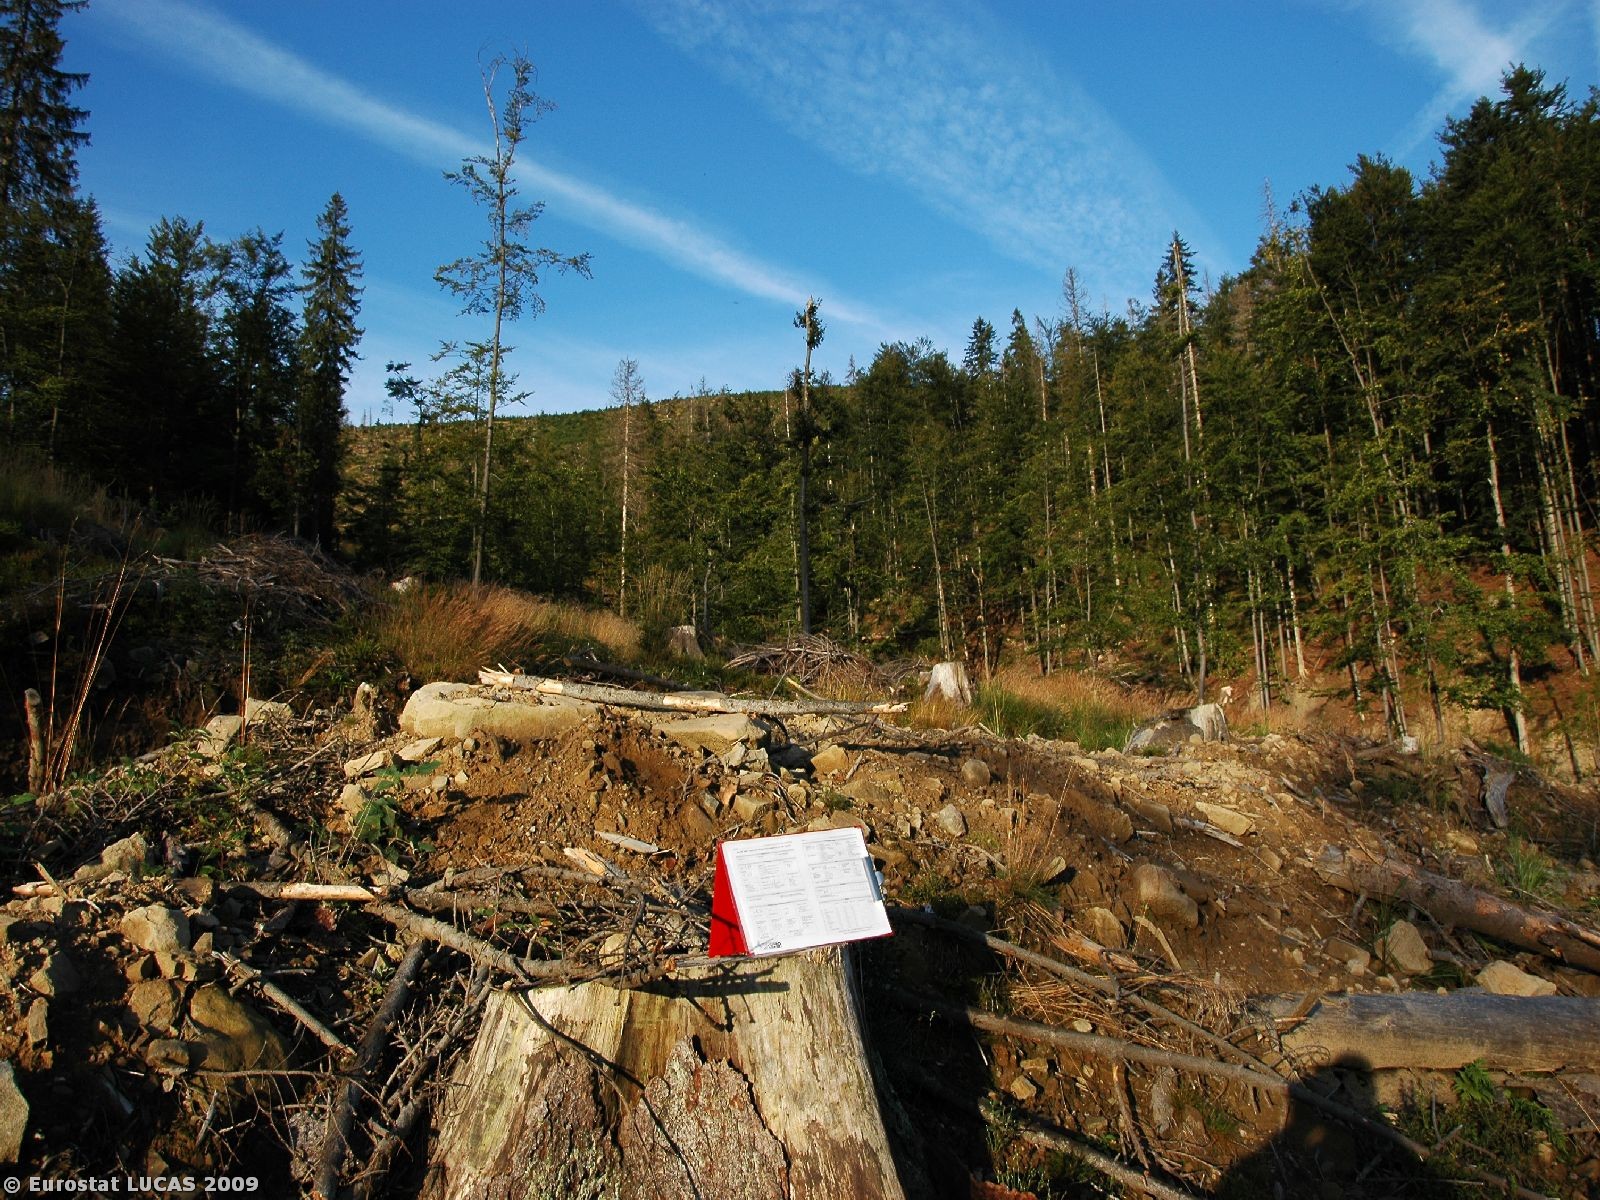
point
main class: Bare land
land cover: Bare land
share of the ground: > 75 %
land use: Forestry
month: September
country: PL
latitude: 49.6459
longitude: 19.0108
